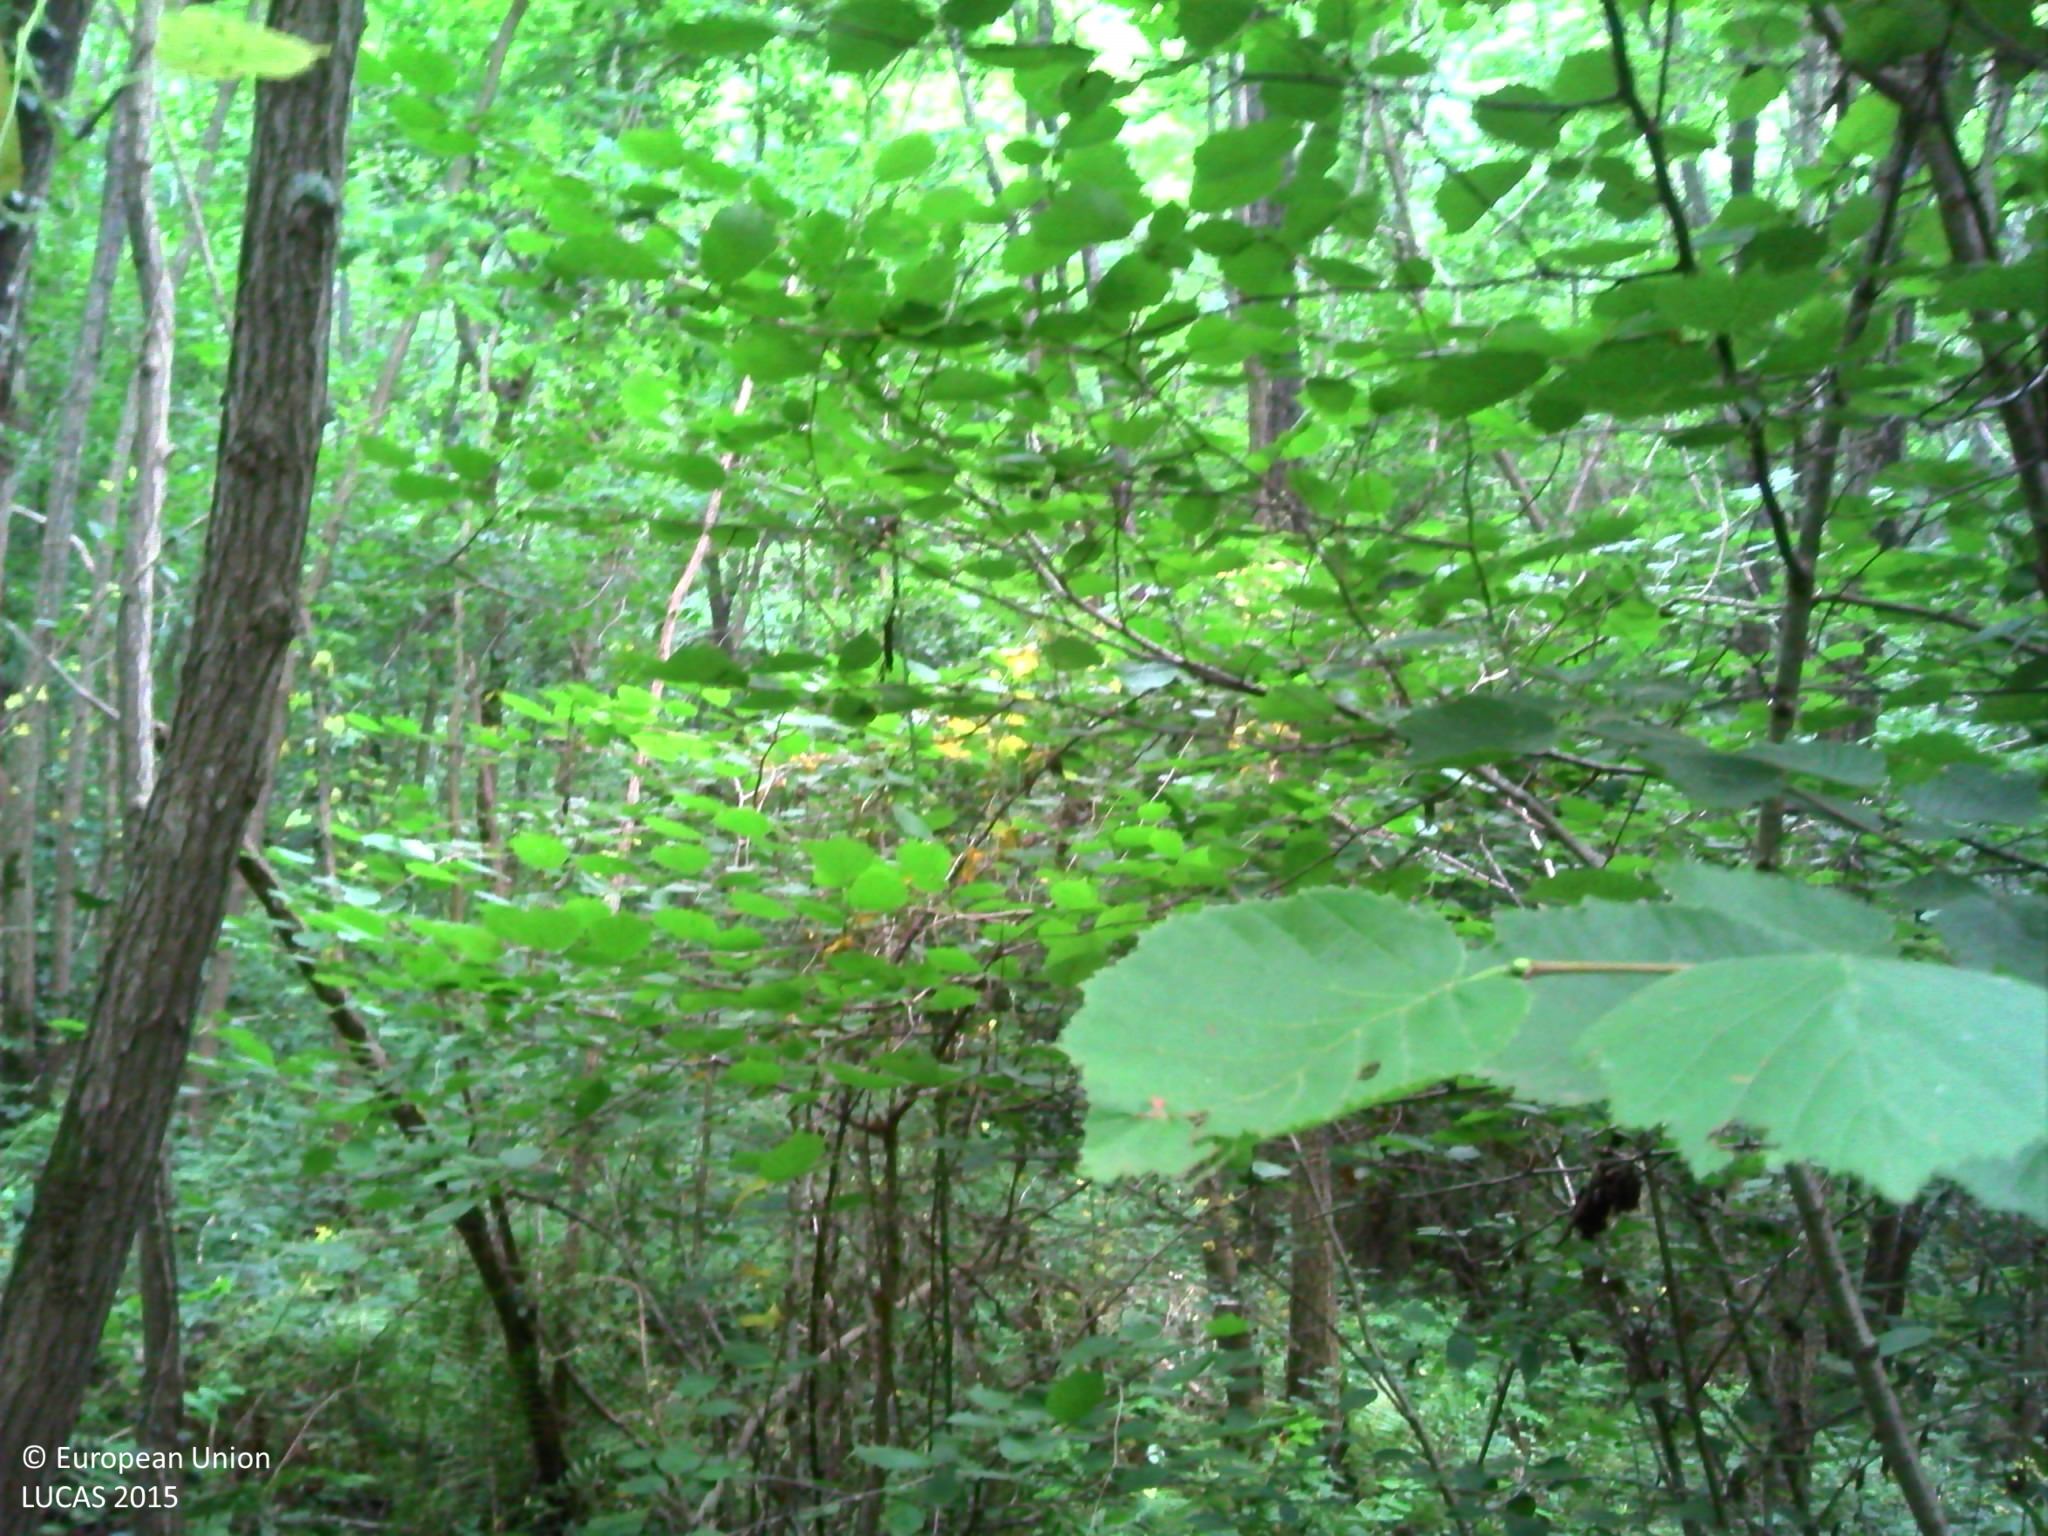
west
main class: Woodland
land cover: Broadleaved woodland
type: thermophilous deciduous forest
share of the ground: > 75 %
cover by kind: broadleaved forest trees 80 %, shrubs 10 %, herbaceous plants 5 %, lichens and mosses 5 %
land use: Forestry
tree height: > 5 m
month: August
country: FR
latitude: 43.3371
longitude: -1.0771
